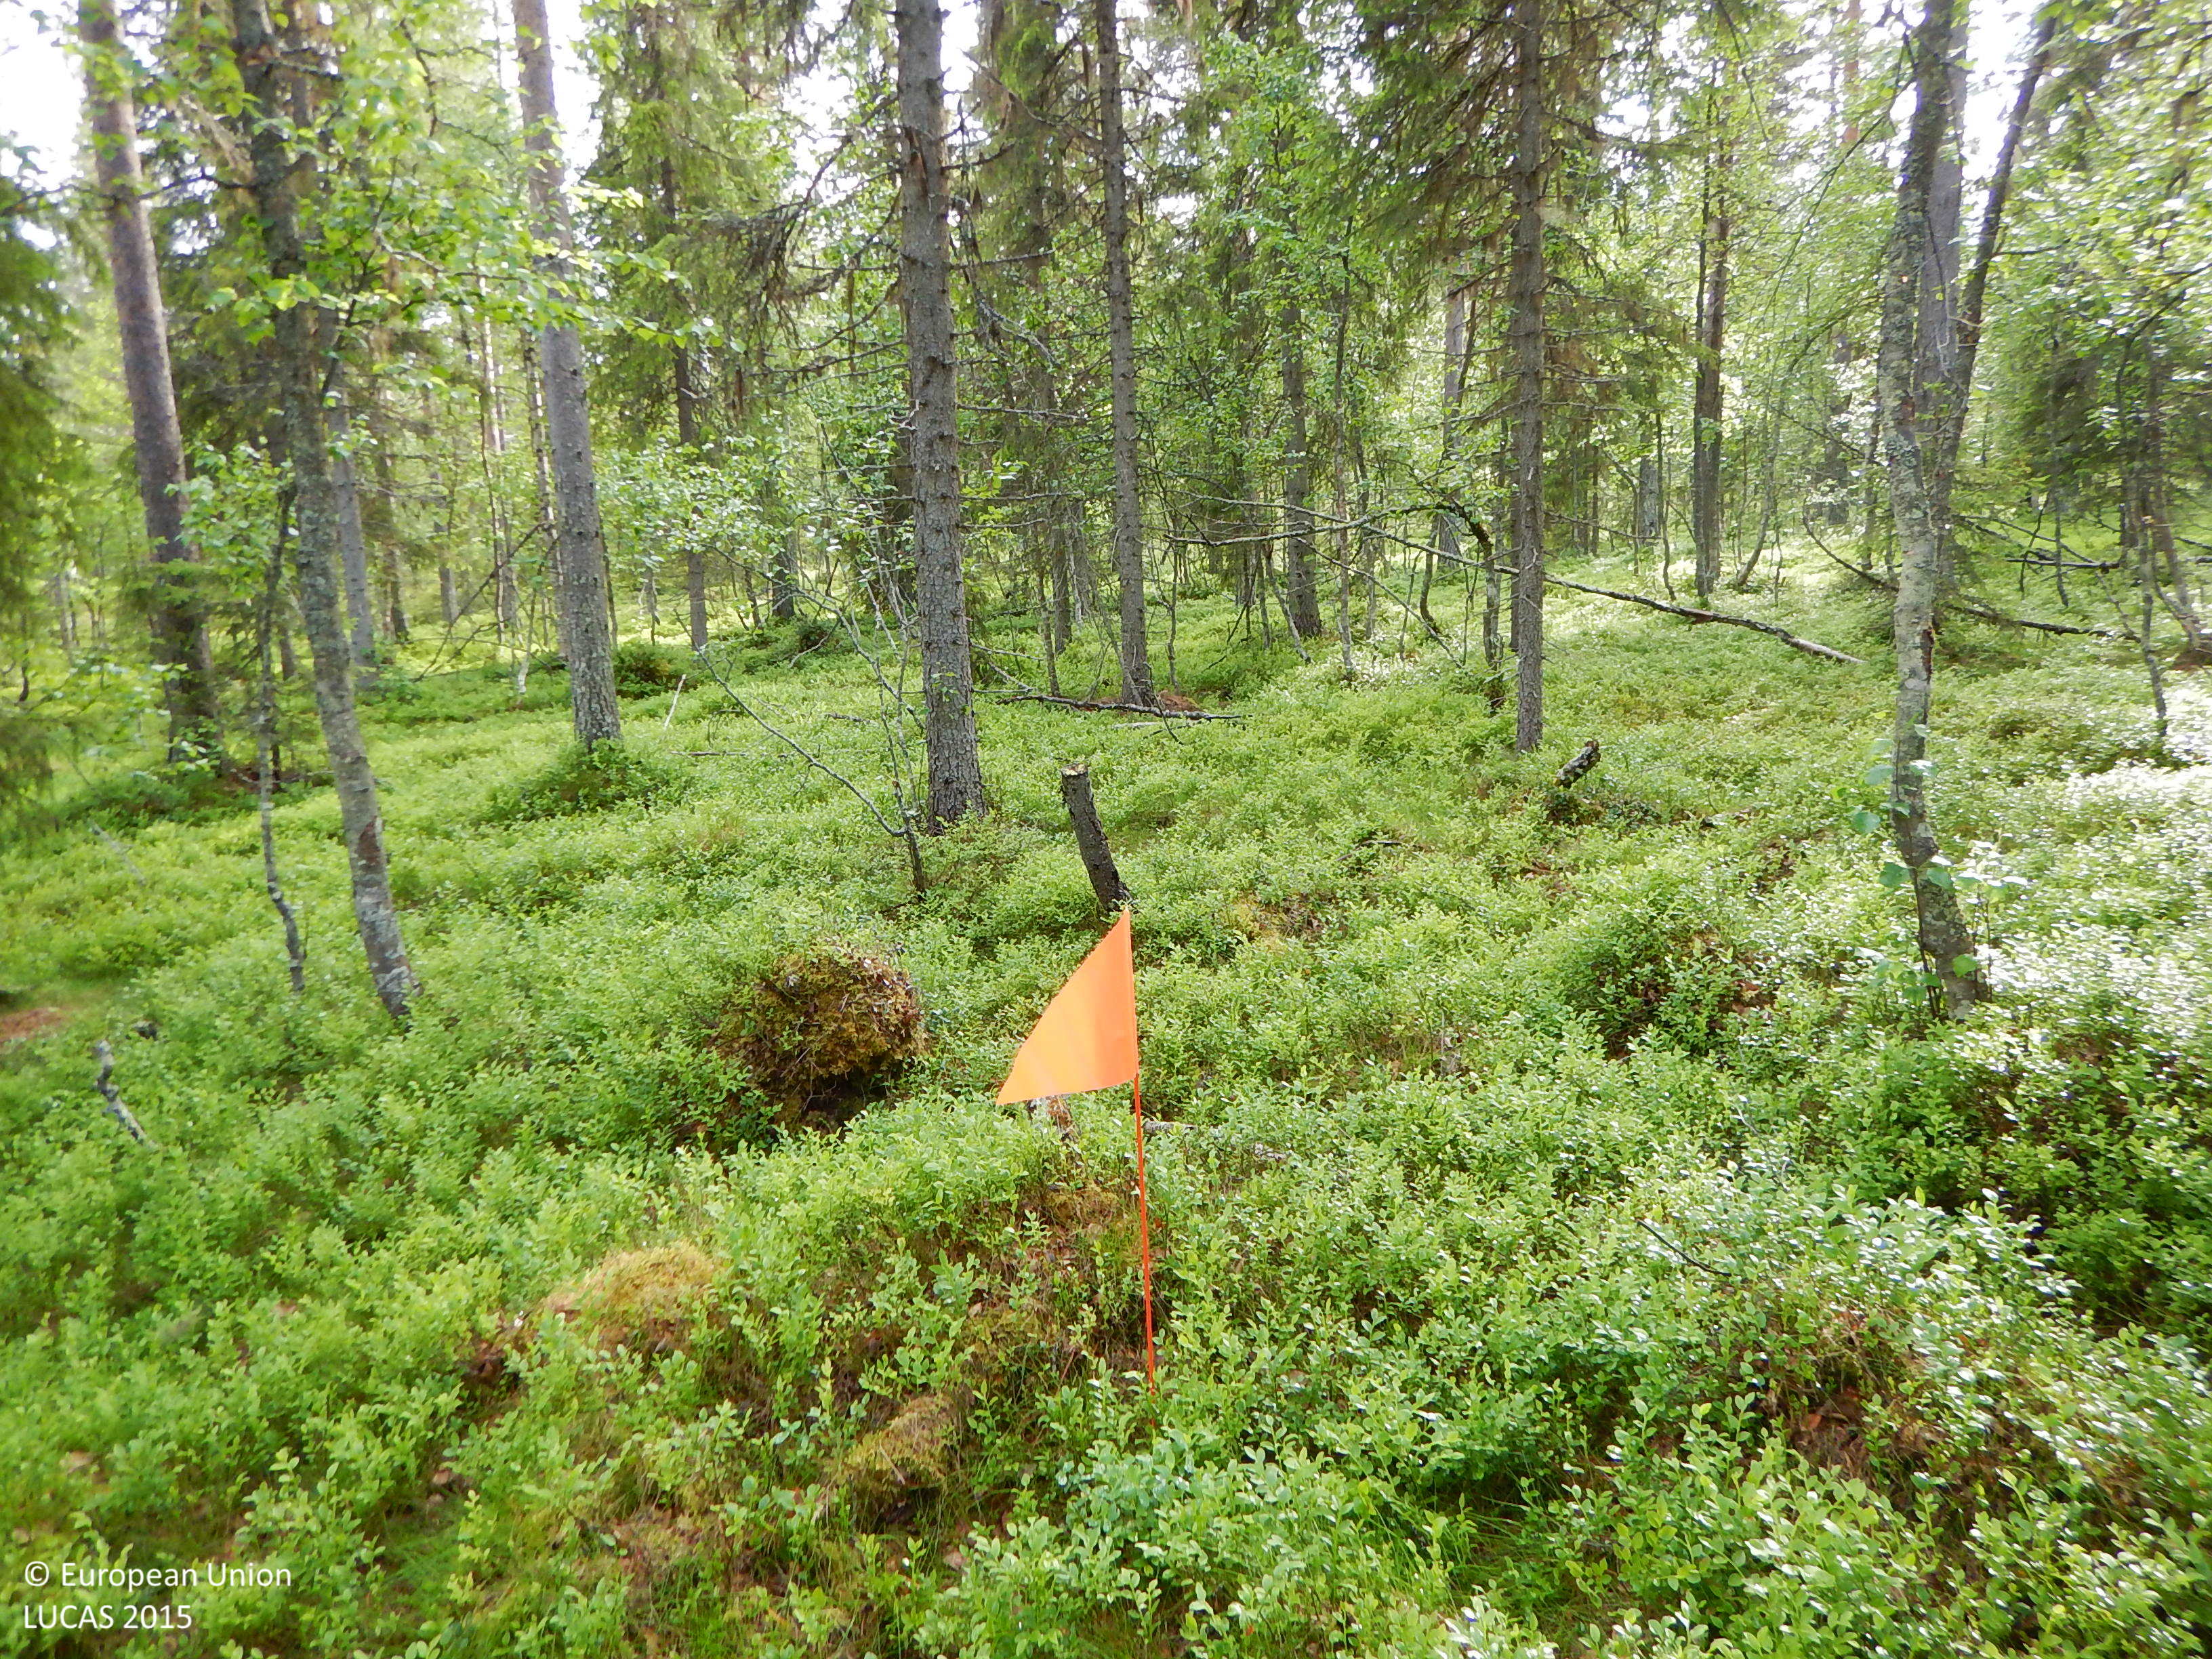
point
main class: Woodland
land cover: Other mixed woodland
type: boreal forest
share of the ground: 50 - 75 %
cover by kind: coniferous forest trees 45 %, shrubs 20 %, broadleaved forest trees 15 %, herbaceous plants 15 %, lichens and mosses 5 %
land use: Forestry
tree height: > 5 m
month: July
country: SE
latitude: 65.2935
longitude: 19.2479
